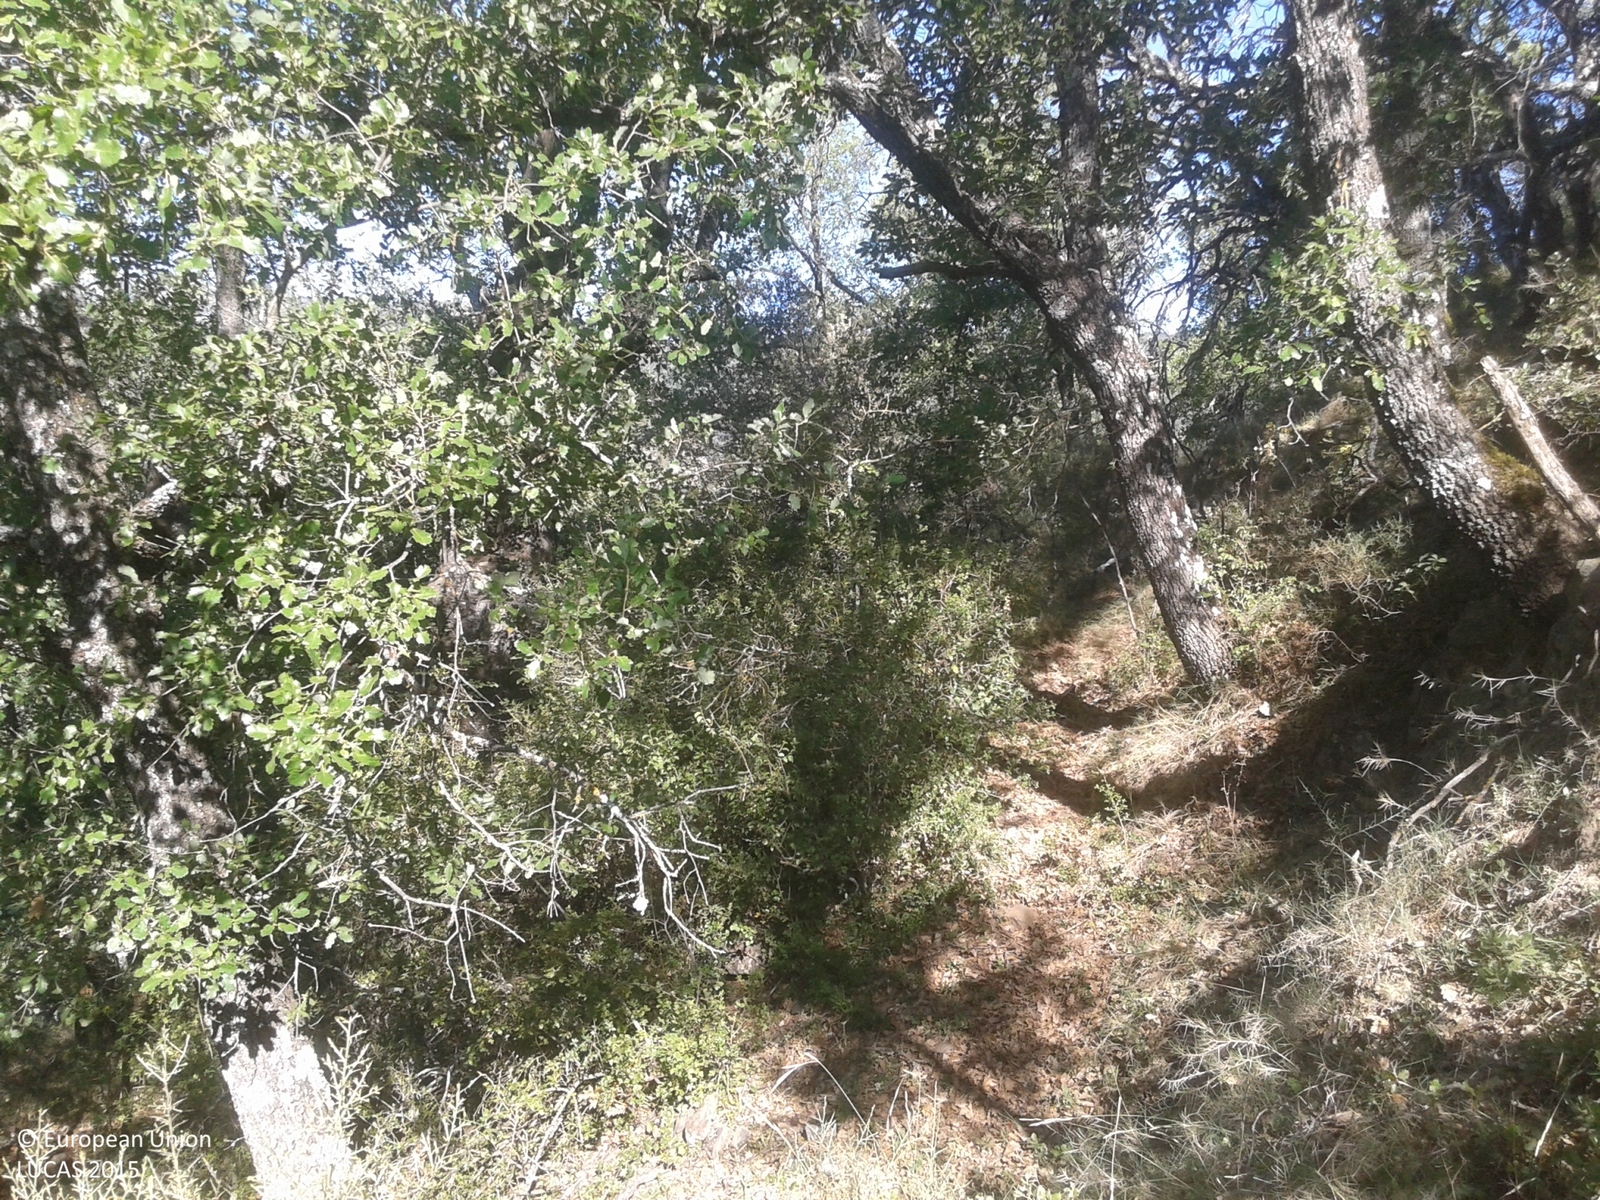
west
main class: Woodland
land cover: Broadleaved woodland
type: broadleaved evergreen forest
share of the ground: 50 - 75 %
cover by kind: broadleaved forest trees 50 %, shrubs 35 %, herbaceous plants 10 %, consolidated bare surface 5 %
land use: Semi-natural and natural areas not in use
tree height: > 5 m
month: July
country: ES
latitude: 42.3131
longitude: 1.0671
